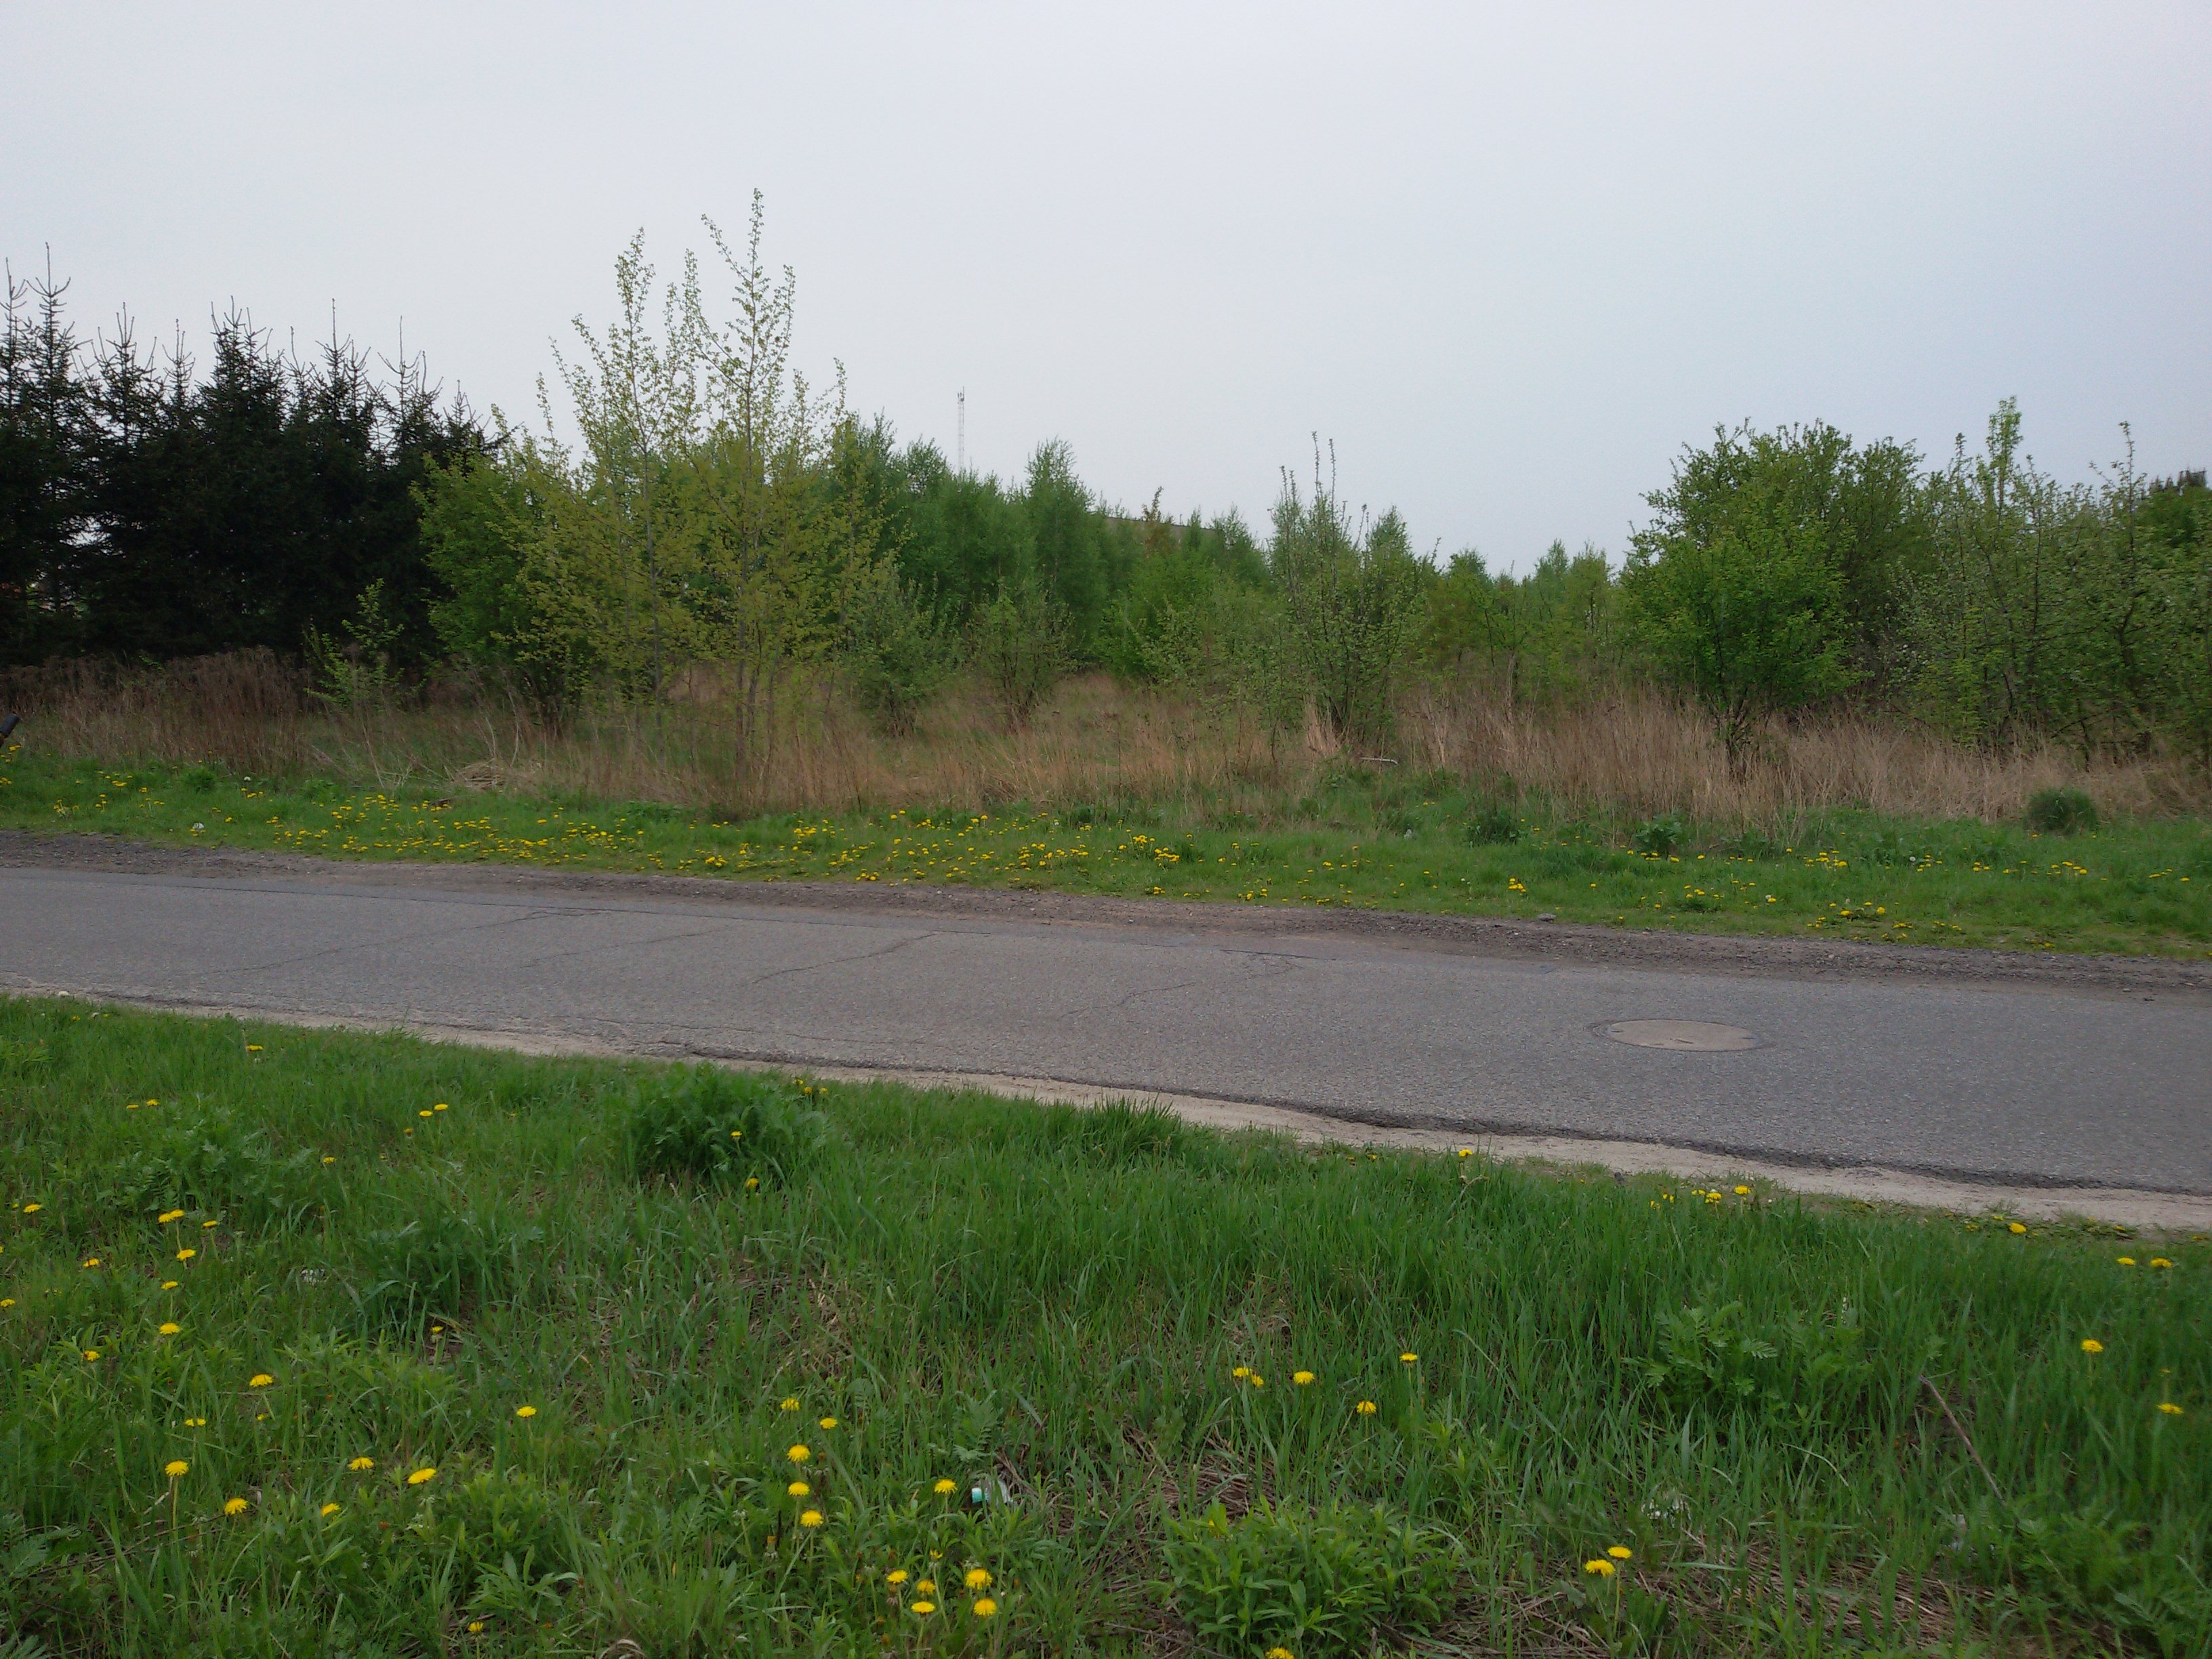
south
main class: Grassland
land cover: Spontaneously vegetated surfaces
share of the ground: > 75 %
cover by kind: herbaceous plants 100 %
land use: Fallow land
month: May
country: PL
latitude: 52.0454
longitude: 23.1271
